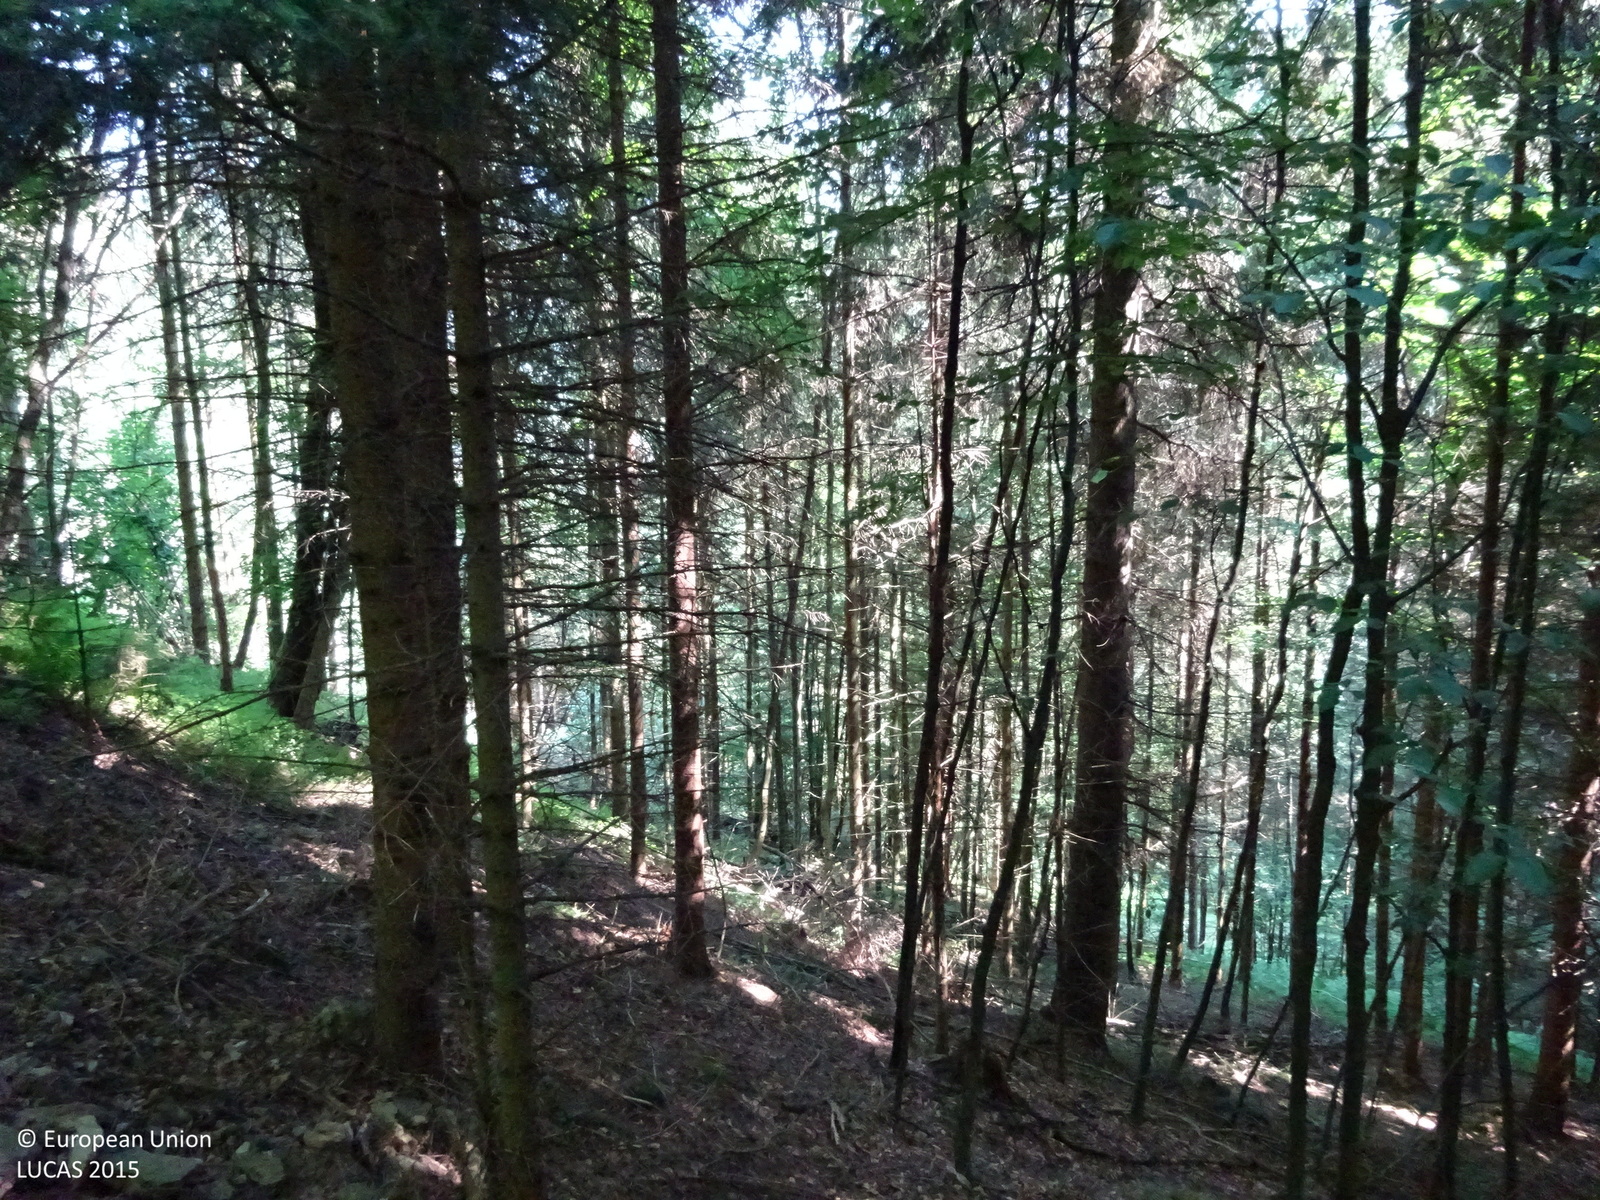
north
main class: Woodland
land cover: Spruce dominated coniferous woodland
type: alpine coniferous forest
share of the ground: > 75 %
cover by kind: coniferous forest trees 85 %, broadleaved forest trees 5 %, herbaceous plants 5 %, unconsolidated bare surface 5 %
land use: Forestry
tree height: > 5 m
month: July
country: AT
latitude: 47.2139
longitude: 15.2682
